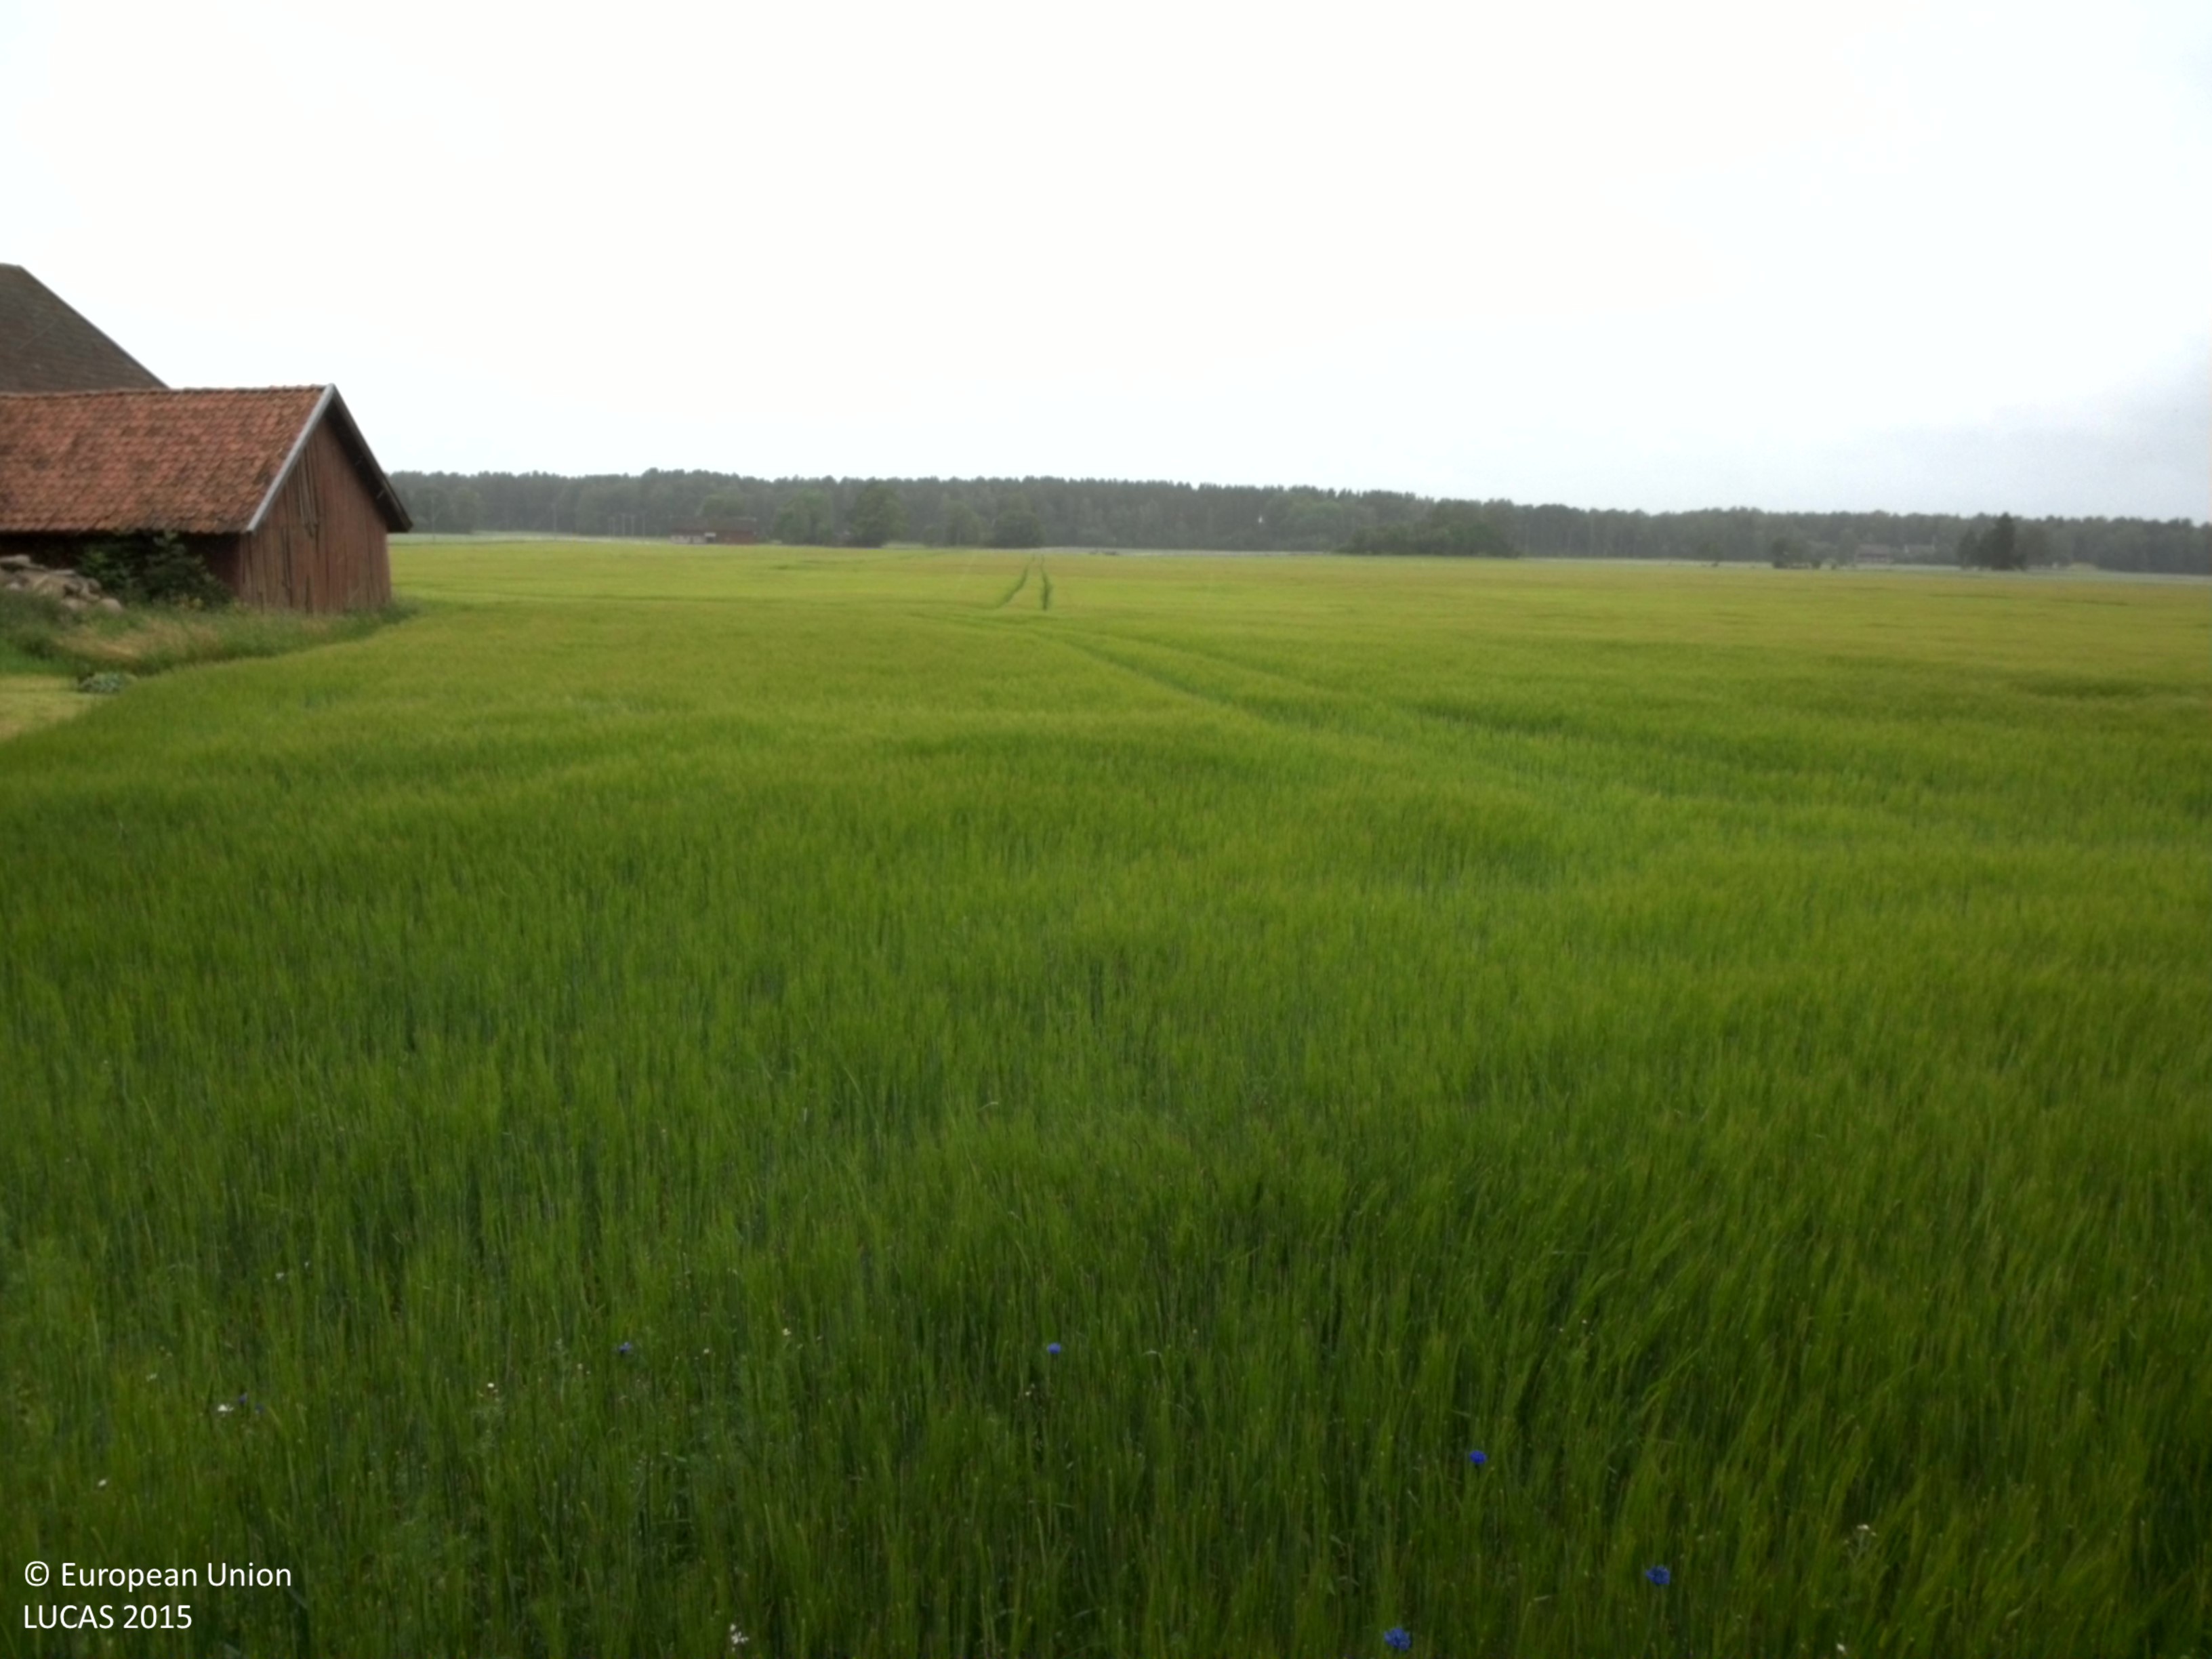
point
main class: Cropland
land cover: Barley
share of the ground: > 75 %
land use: Agriculture (excluding fallow land and kitchen gardens)
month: July
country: SE
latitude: 58.5045
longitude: 13.9235
